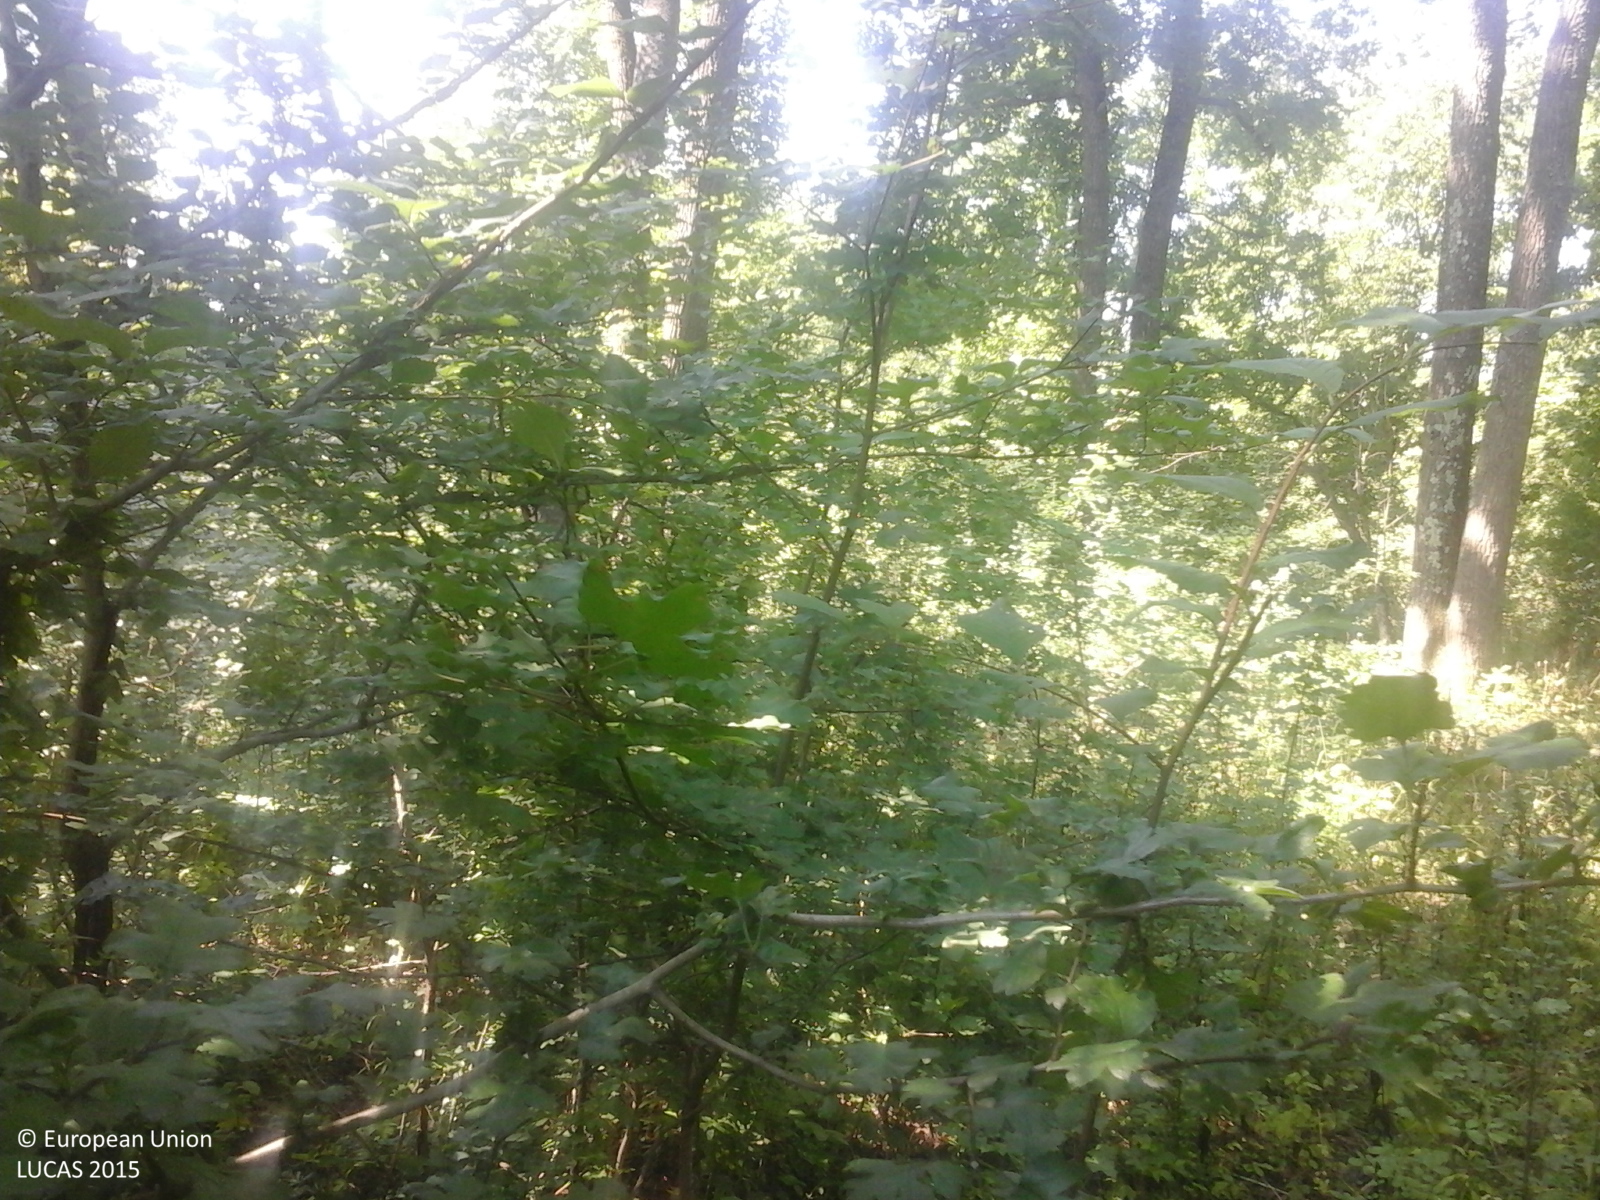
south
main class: Woodland
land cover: Broadleaved woodland
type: mesophytic deciduous forest
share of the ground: > 75 %
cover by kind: broadleaved forest trees 90 %, shrubs 5 %, herbaceous plants 5 %
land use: Forestry
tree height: > 5 m
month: July
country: RO
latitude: 44.1832
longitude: 24.3894
